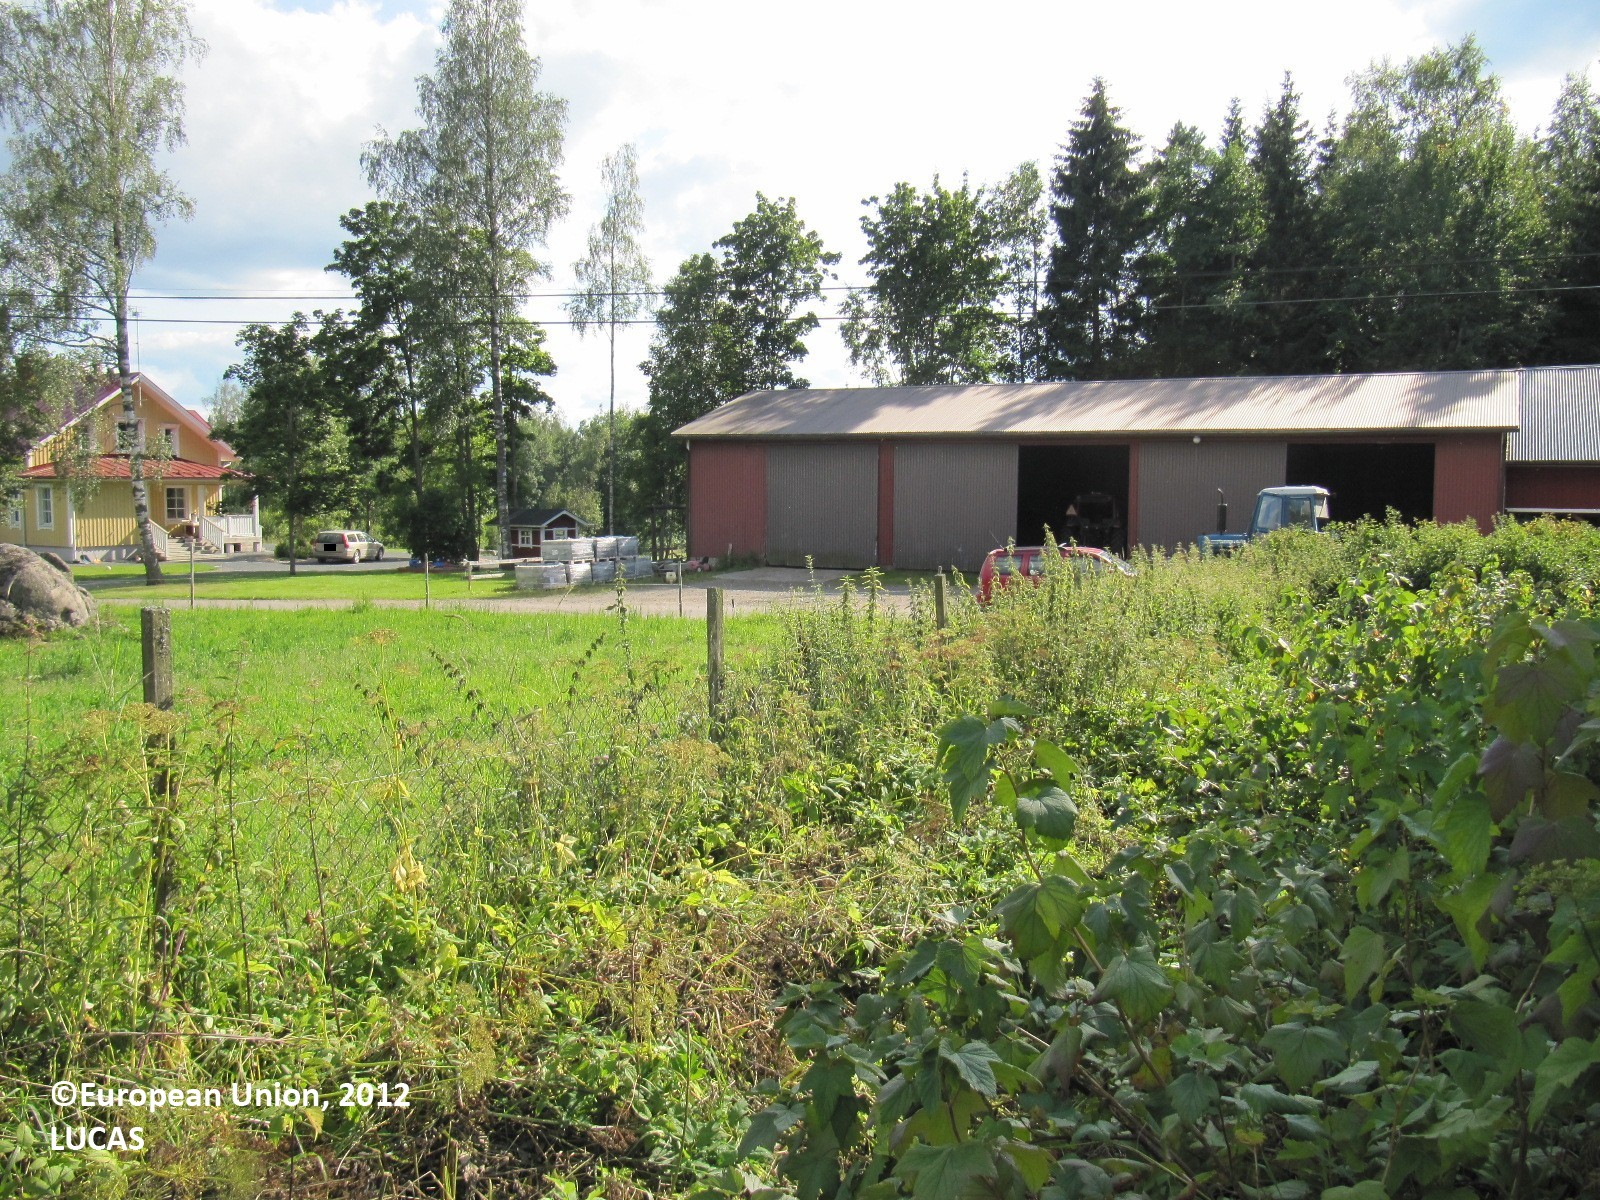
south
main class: Cropland
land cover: Other fruit trees and berries
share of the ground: 50 - 75 %
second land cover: Apple fruit
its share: 25 - 50 %
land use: Kitchen garden
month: August
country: FI
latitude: 60.5887
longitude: 24.4348
